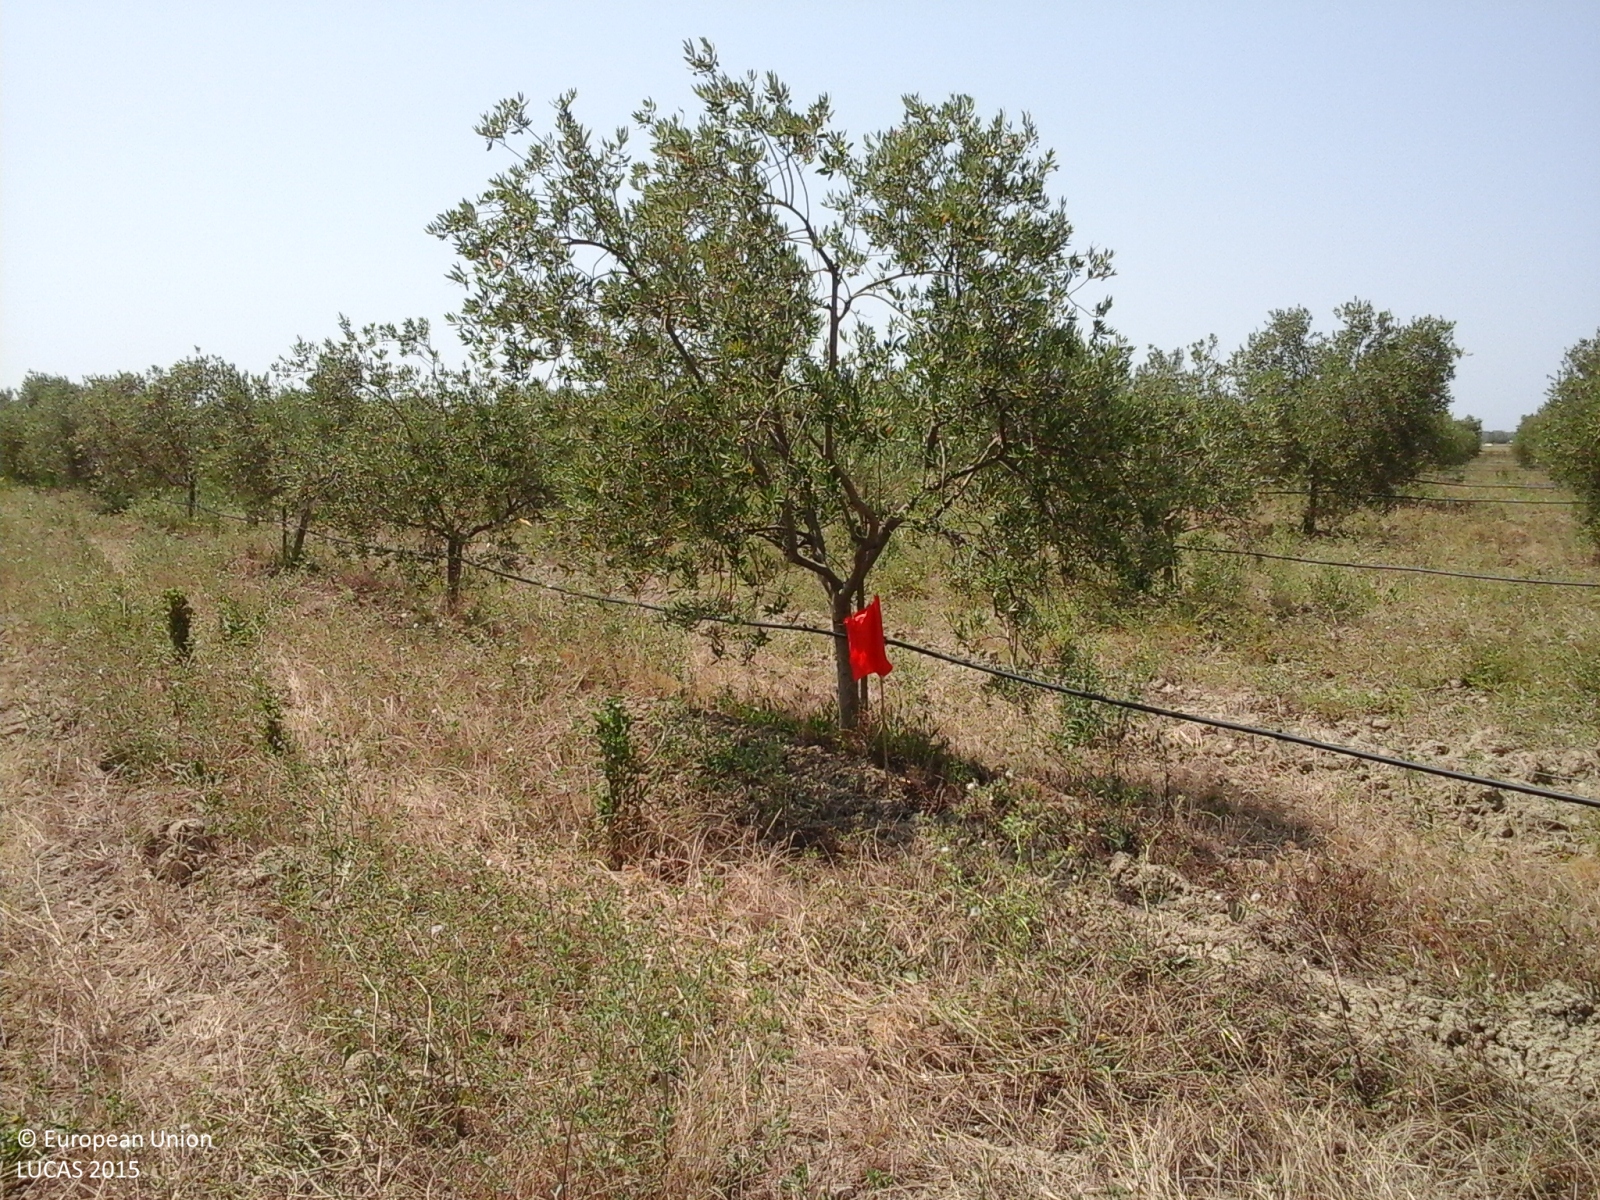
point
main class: Cropland
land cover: Olive groves
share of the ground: 50 - 75 %
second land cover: Grassland without tree/shrub cover
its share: 50 - 75 %
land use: Agriculture (excluding fallow land and kitchen gardens)
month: July
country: IT
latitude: 42.7576
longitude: 10.9865
